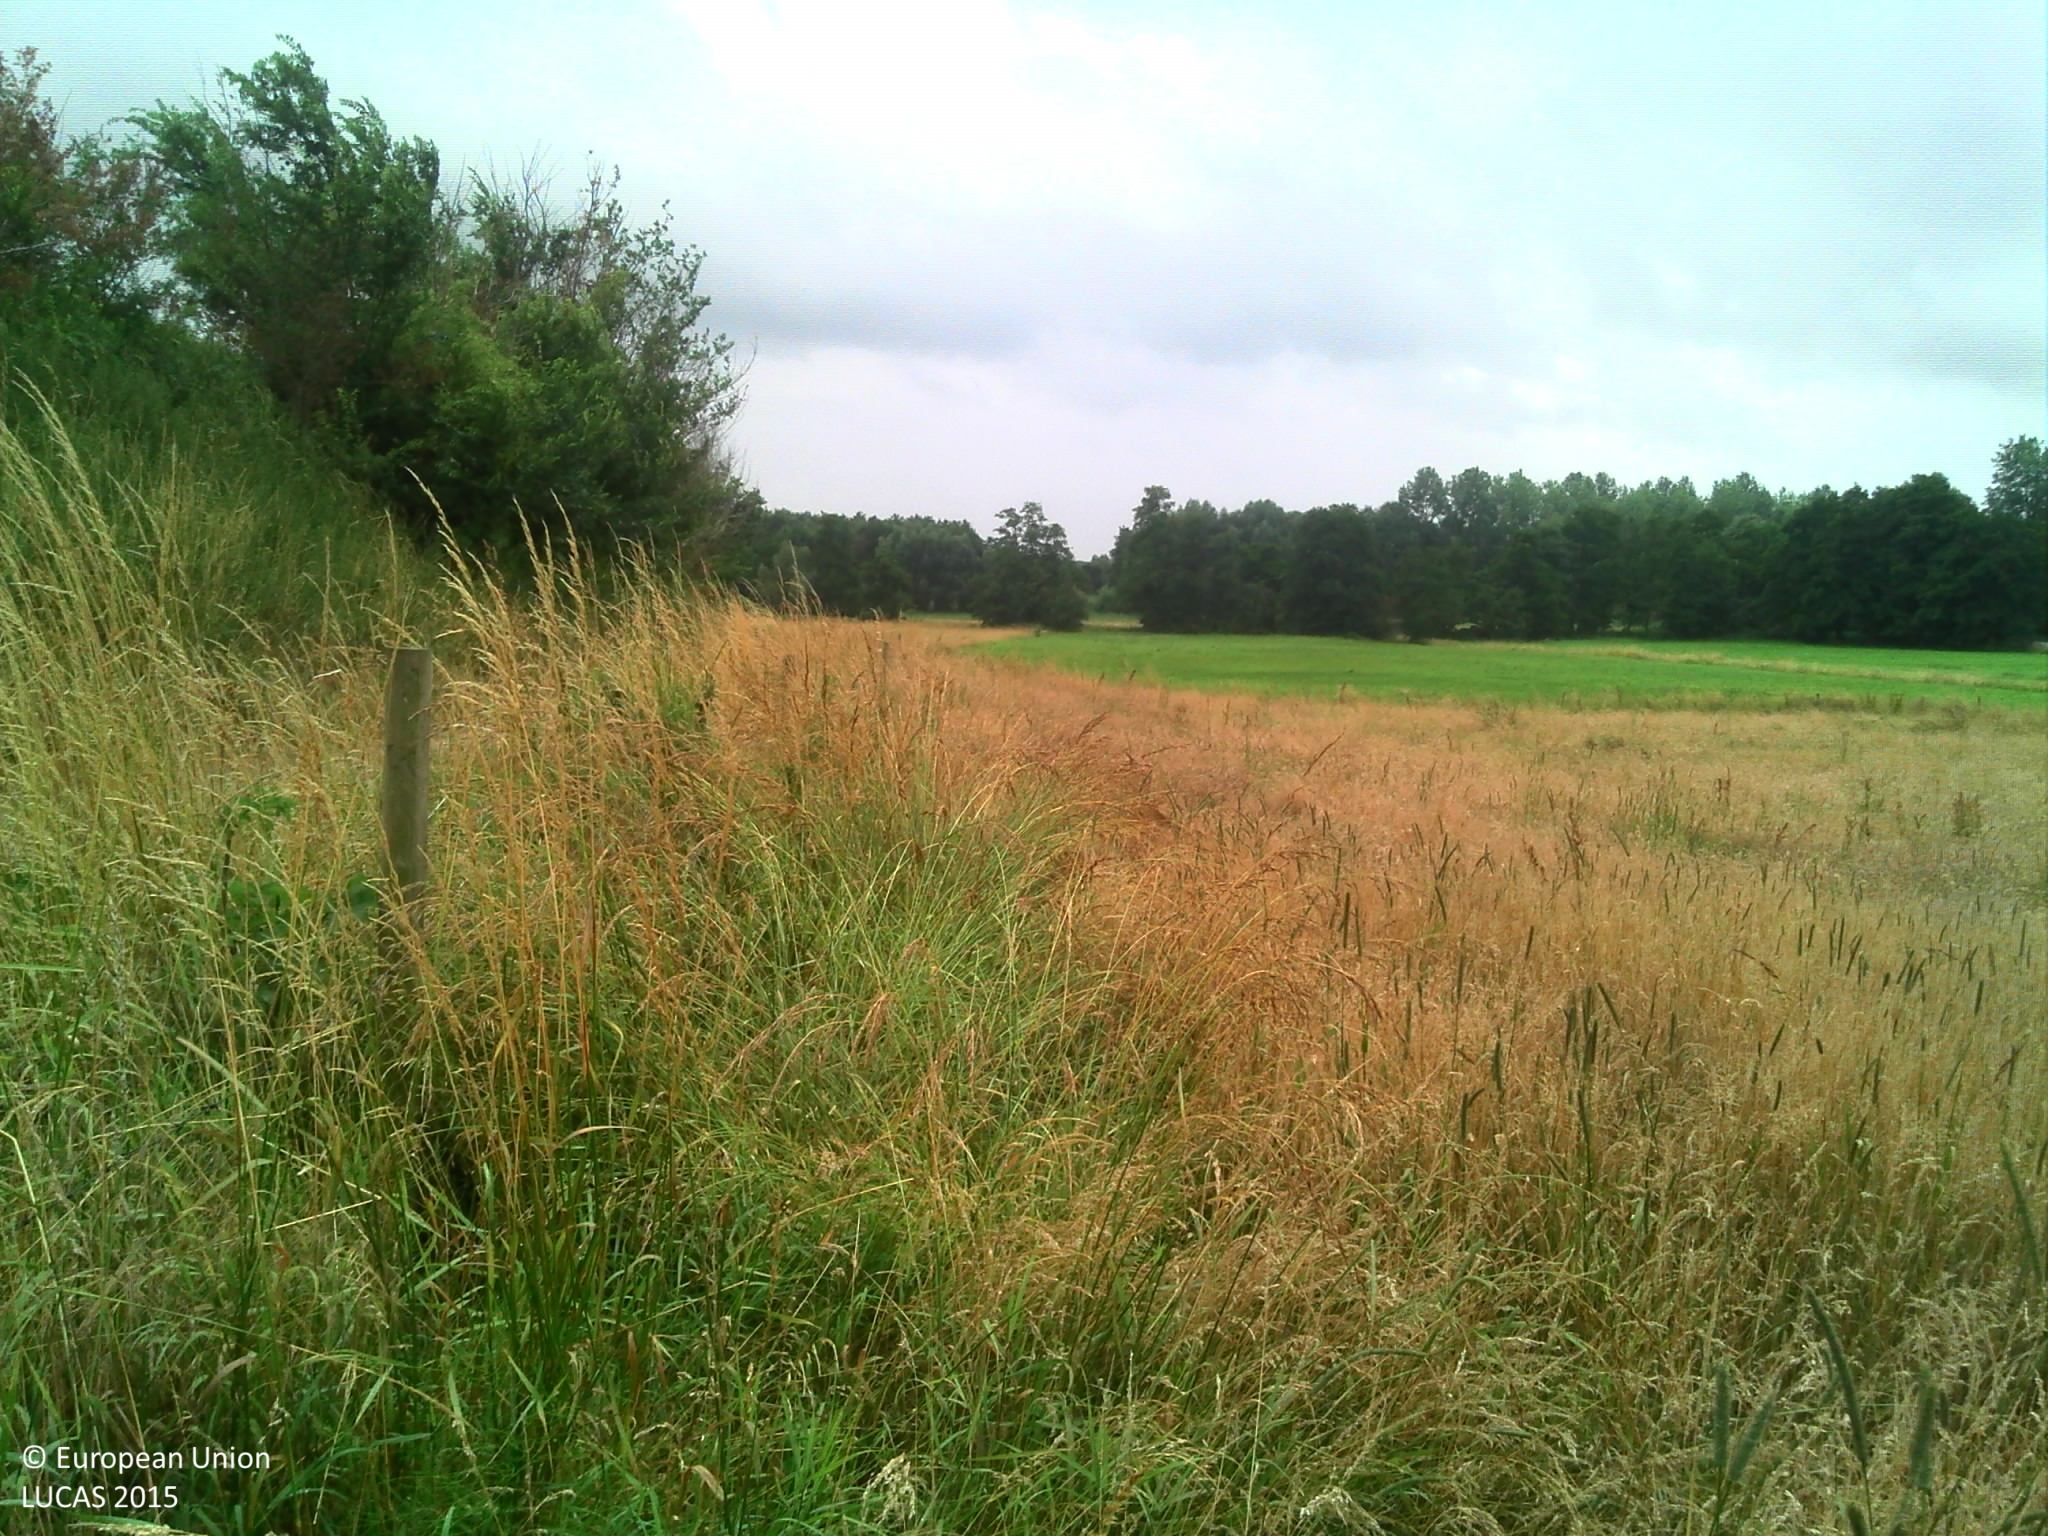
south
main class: Grassland
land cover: Grassland without tree/shrub cover
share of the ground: > 75 %
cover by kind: herbaceous plants 95 %, shrubs 5 %
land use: Agriculture (excluding fallow land and kitchen gardens)
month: July
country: BE
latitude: 50.8064
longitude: 4.8455
